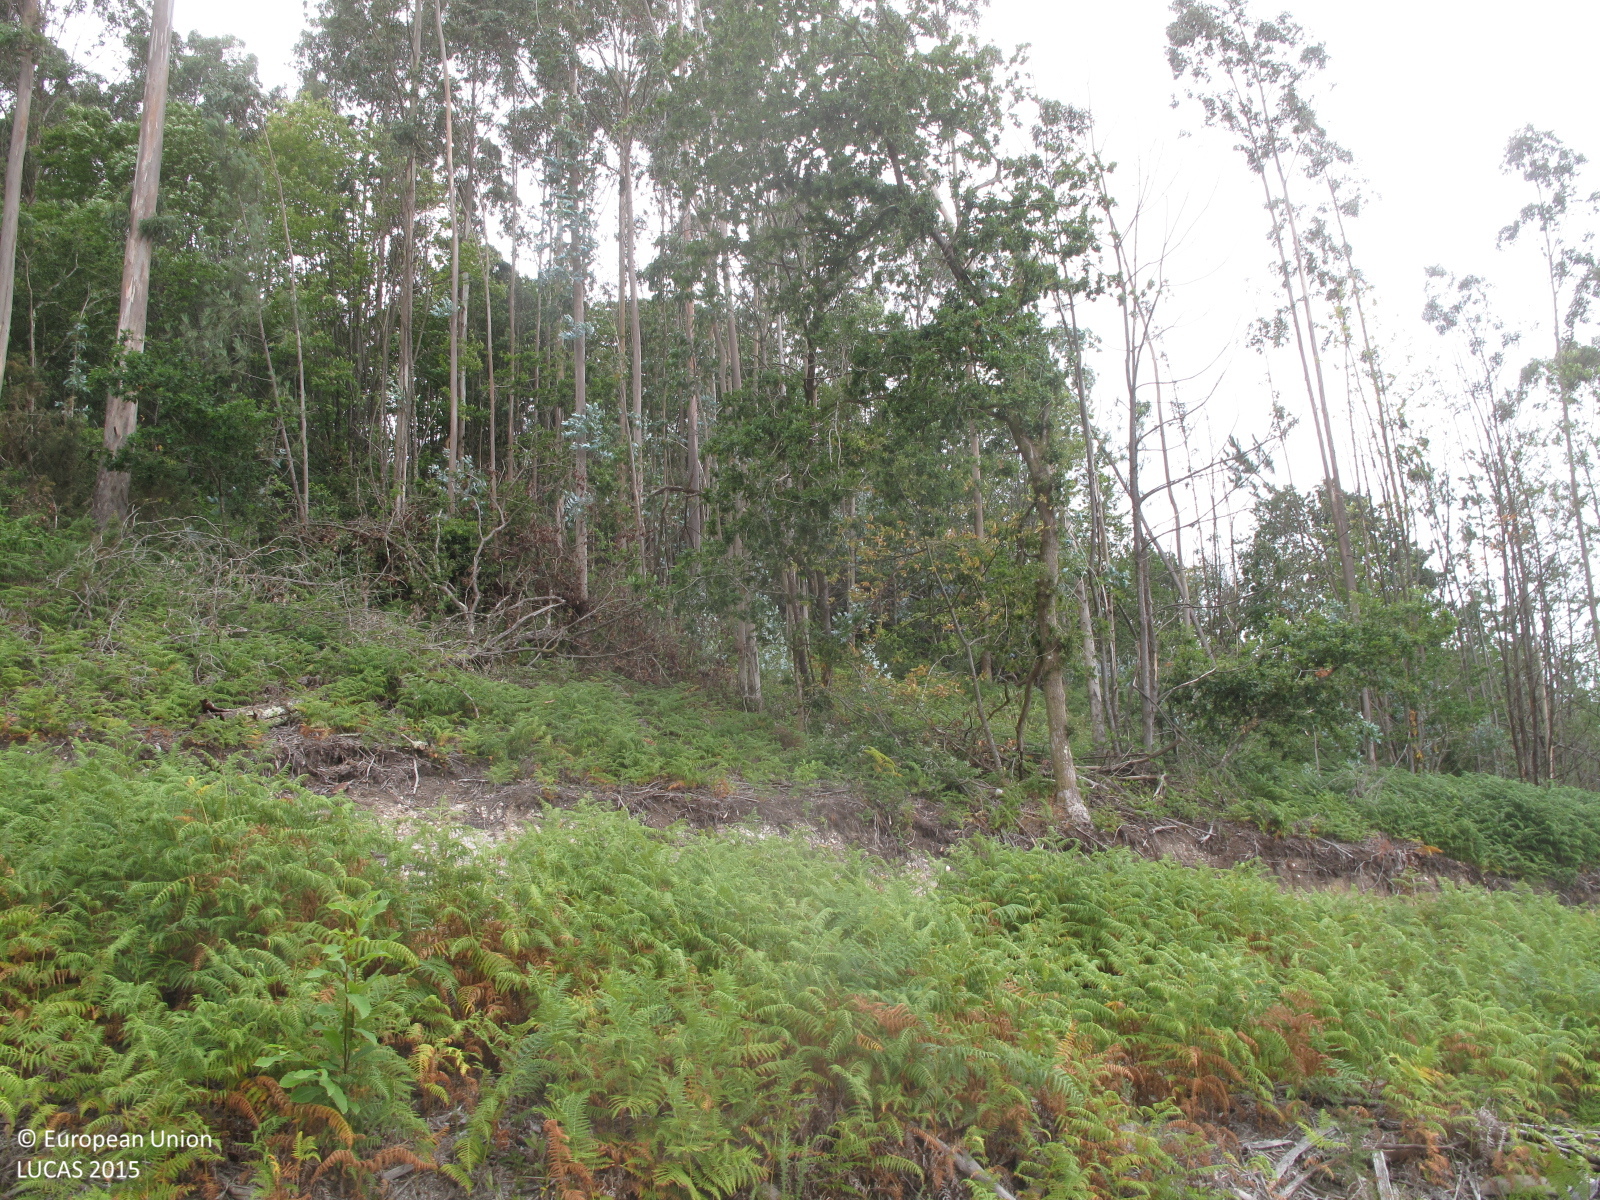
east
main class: Woodland
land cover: Broadleaved woodland
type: exotic forest
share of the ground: 10 - 25 %
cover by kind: herbaceous plants 40 %, broadleaved forest trees 20 %, shrubs 20 %, unconsolidated bare surface 20 %
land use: Forestry
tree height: < 5 m
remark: Clear cut
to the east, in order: Broadleaved woodland
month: July
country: ES
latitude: 43.3824
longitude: -8.1326
